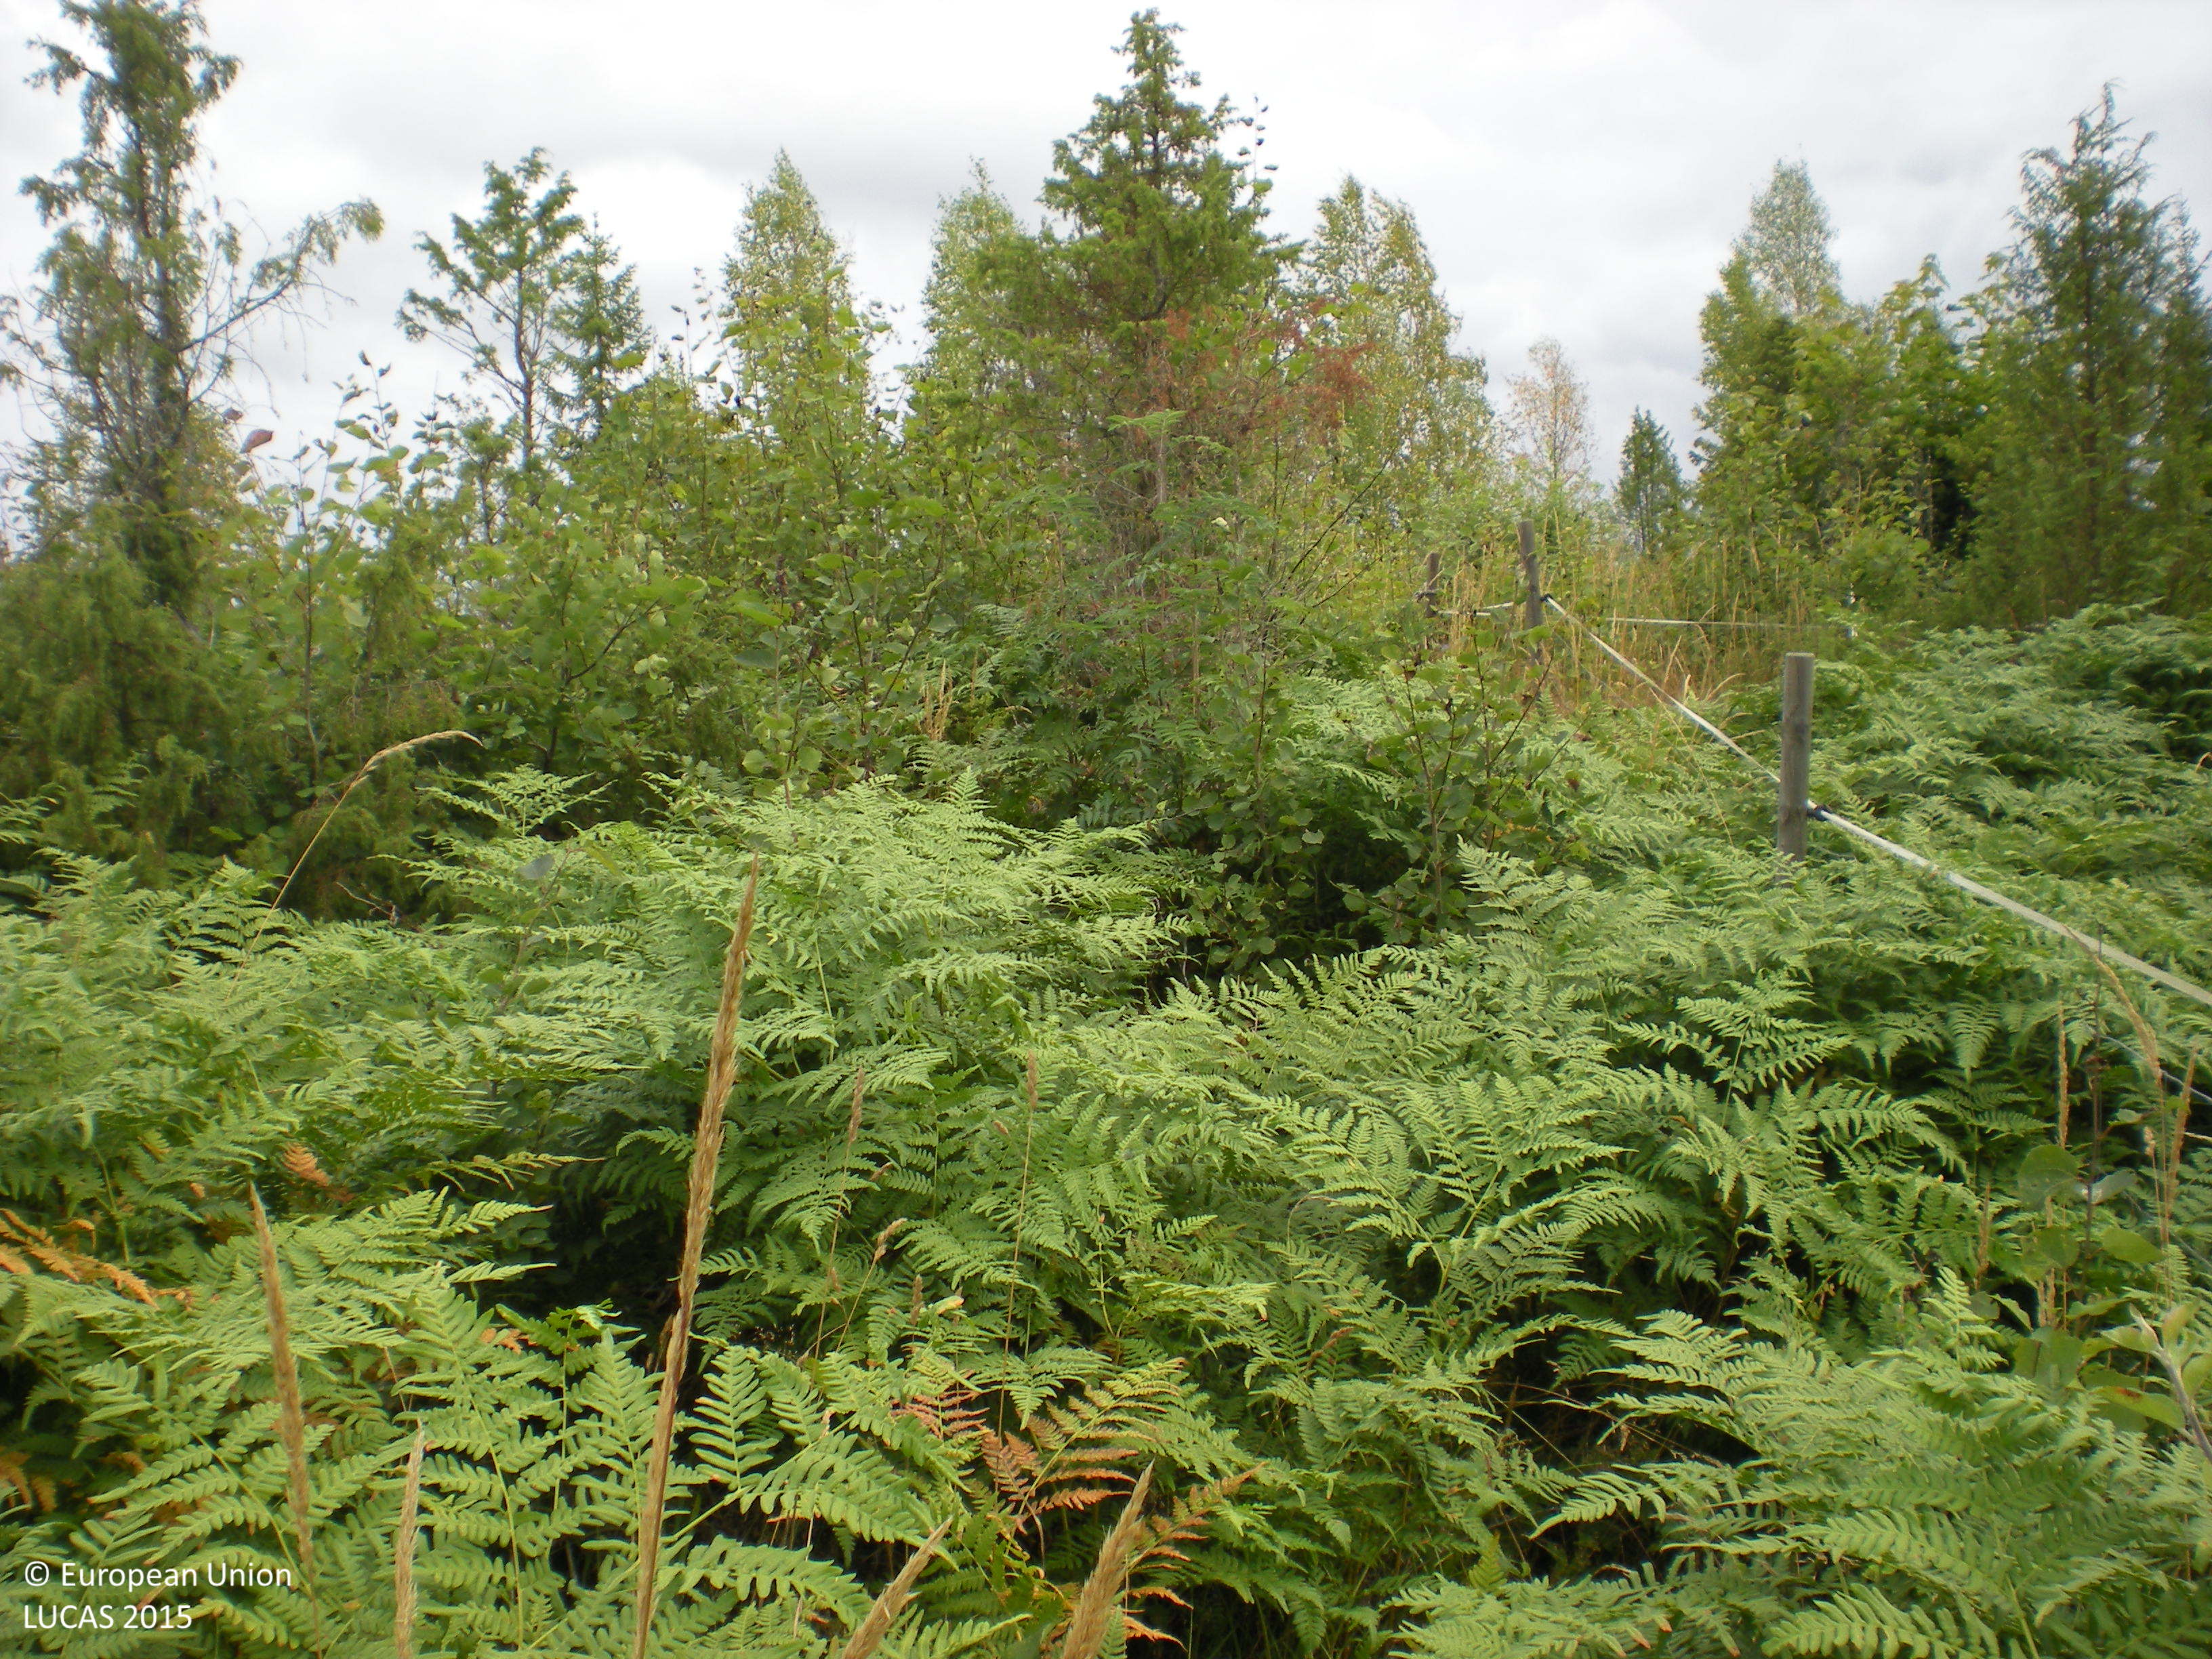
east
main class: Woodland
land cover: Broadleaved woodland
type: hemiboreal forest and nemoral coniferous forest and mixed broadleaved-coniferous forest
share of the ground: 10 - 25 %
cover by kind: herbaceous plants 75 %, broadleaved forest trees 15 %, shrubs 10 %
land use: Forestry
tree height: < 5 m
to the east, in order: Broadleaved woodland; Electric lines; Broadleaved woodland; Other coniferous woodland
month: August
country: SE
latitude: 60.5022
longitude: 17.2181
